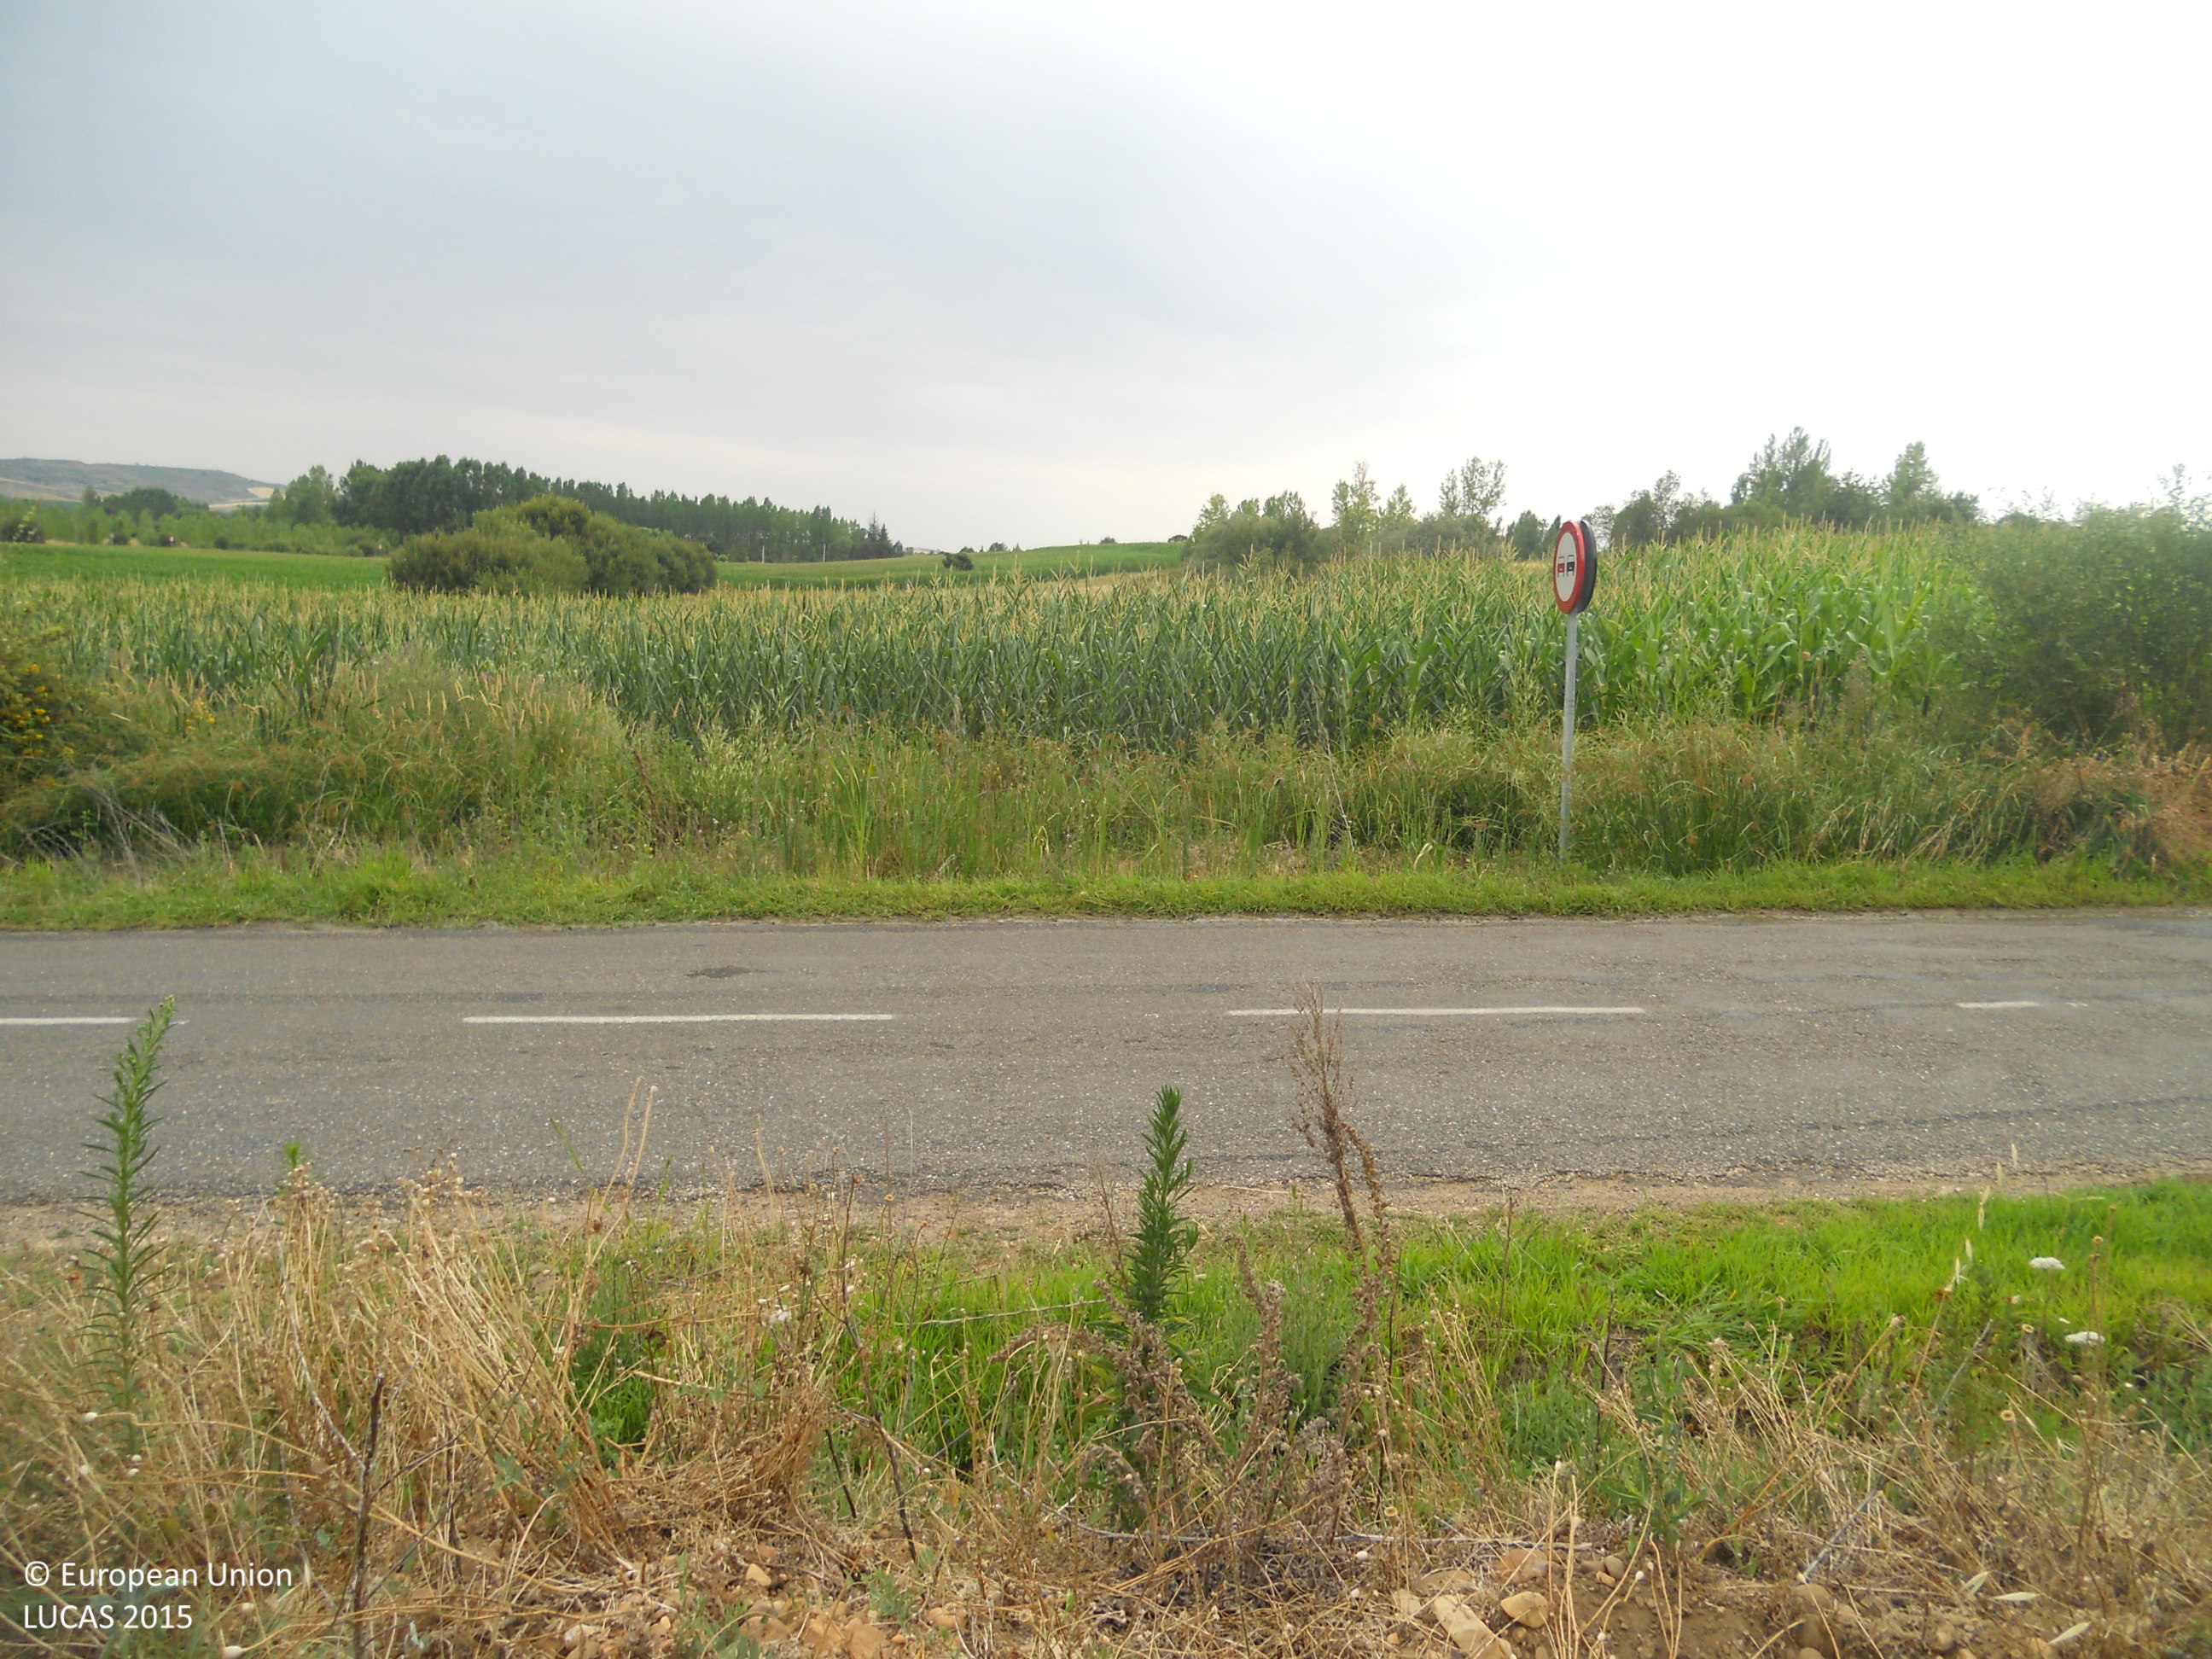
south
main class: Cropland
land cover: Maize
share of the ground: > 75 %
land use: Agriculture (excluding fallow land and kitchen gardens)
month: July
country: ES
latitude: 42.6424
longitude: -5.4004
